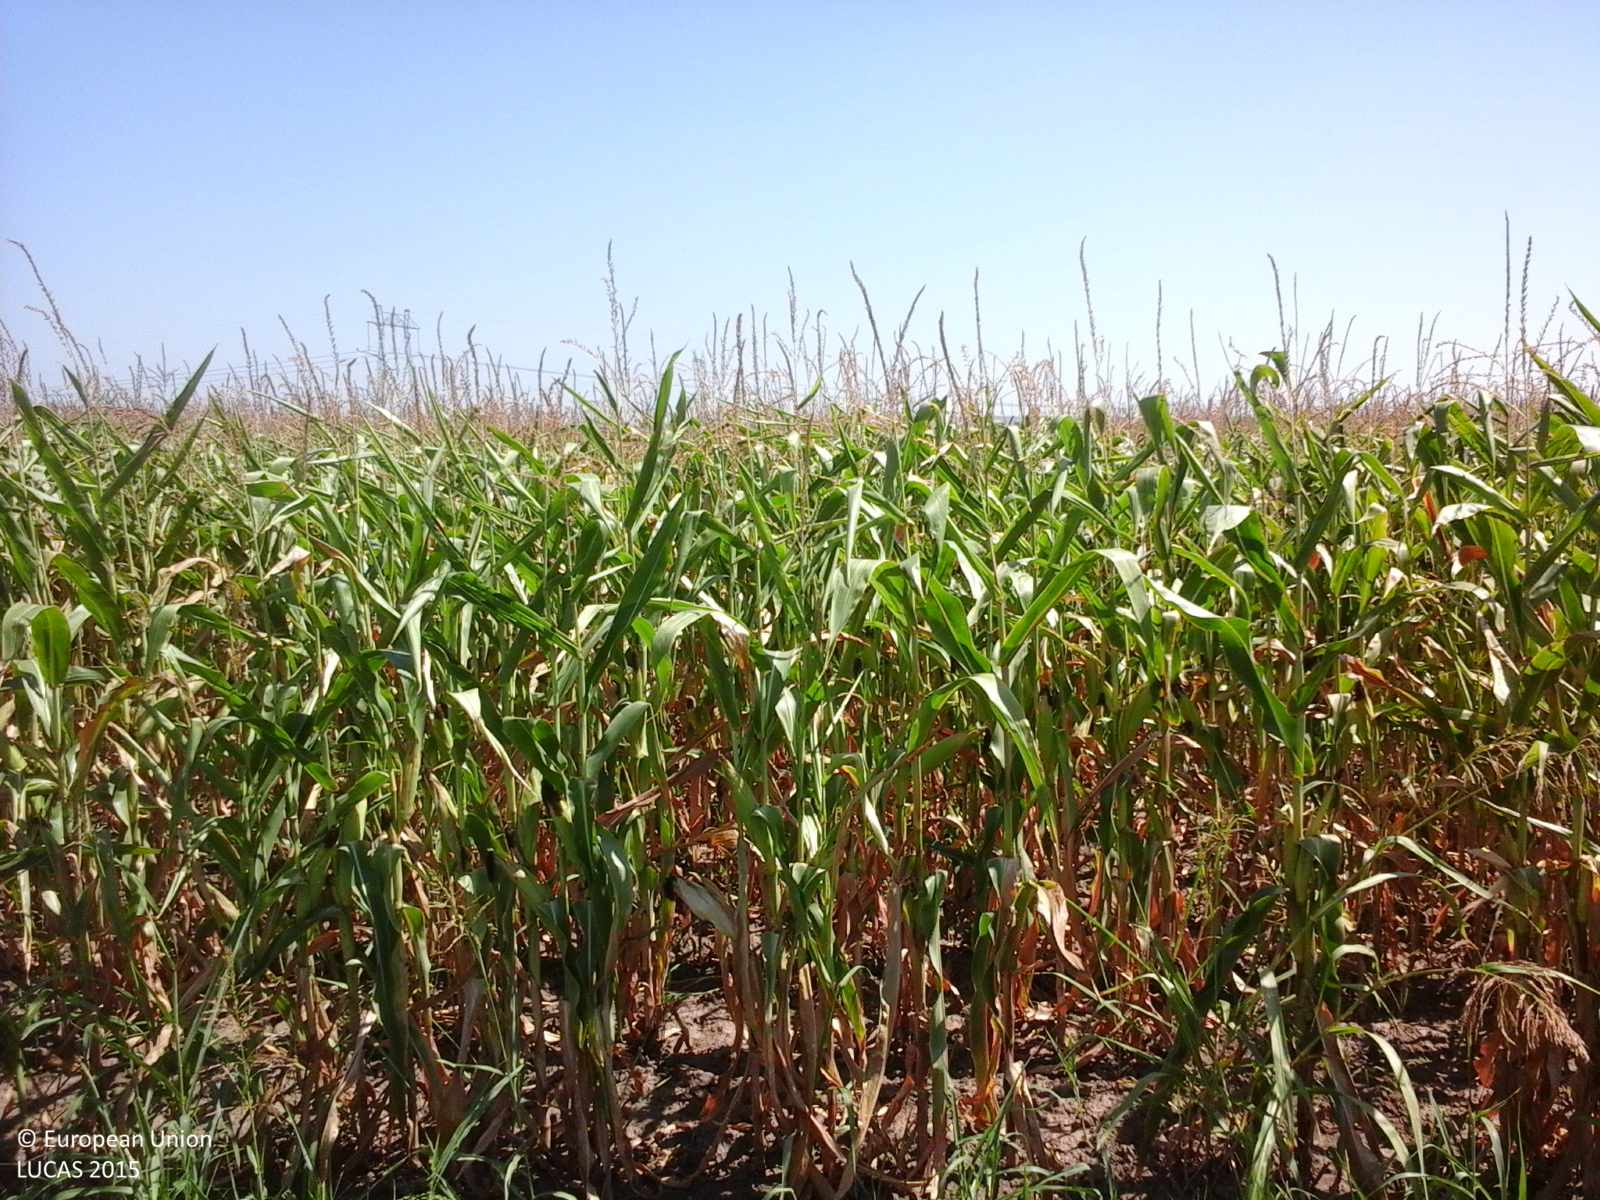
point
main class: Cropland
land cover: Maize
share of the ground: > 75 %
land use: Agriculture (excluding fallow land and kitchen gardens)
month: August
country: RO
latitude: 44.4373
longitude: 28.2177
